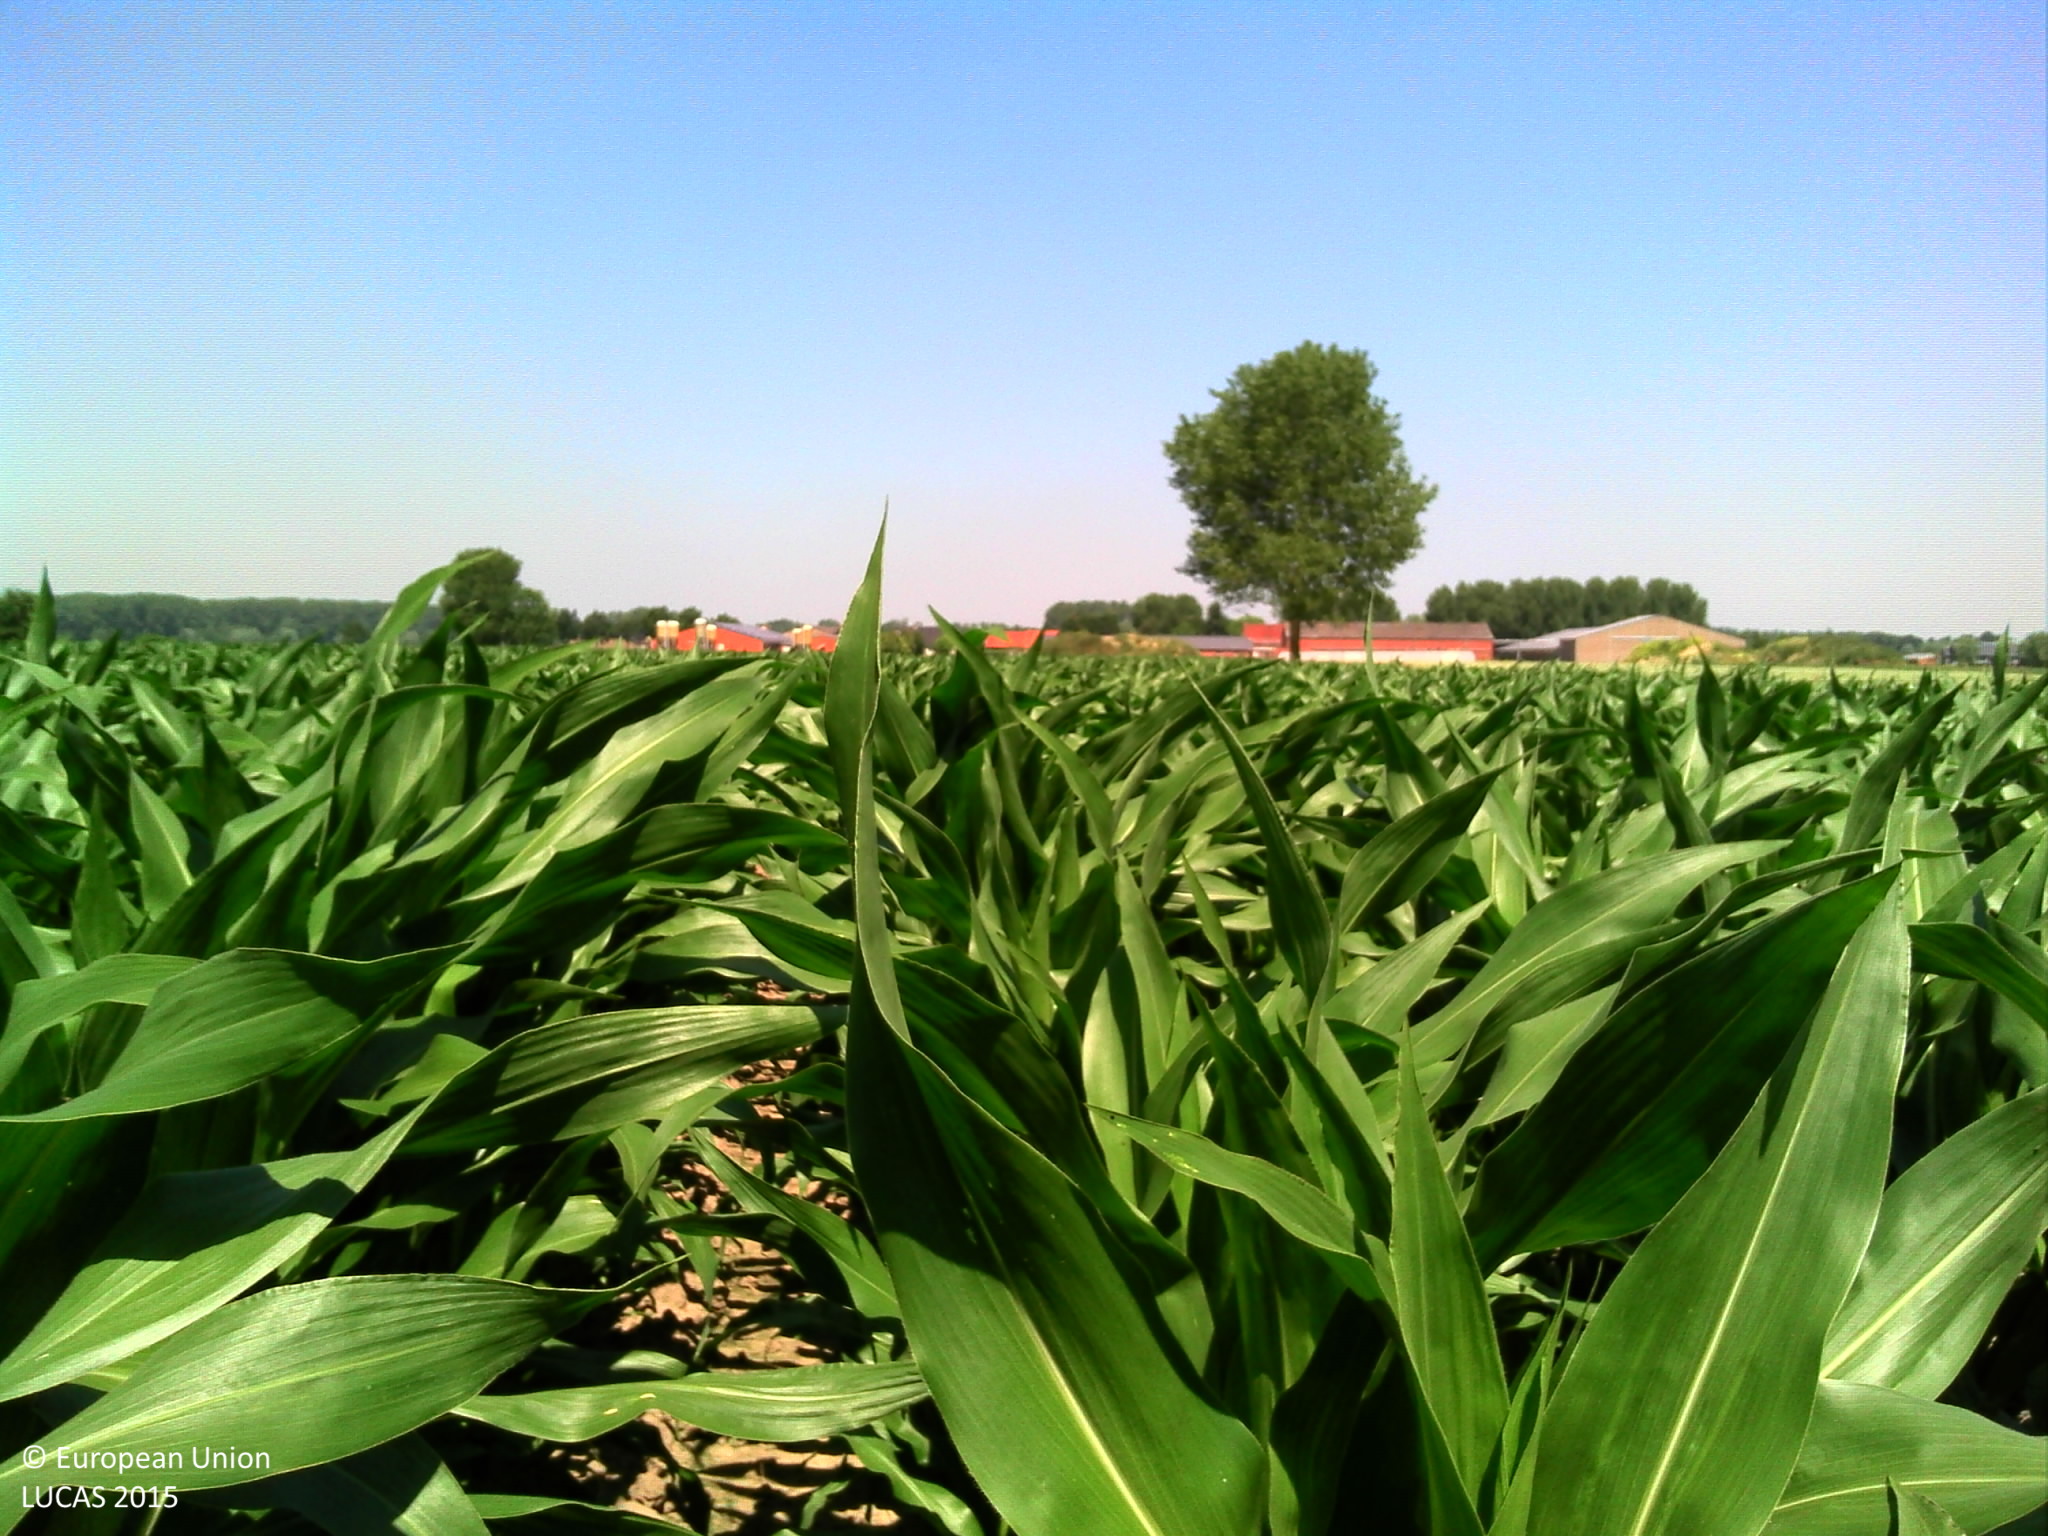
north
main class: Cropland
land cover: Maize
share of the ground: > 75 %
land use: Agriculture (excluding fallow land and kitchen gardens)
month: June
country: BE
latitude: 51.1620
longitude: 3.6581
